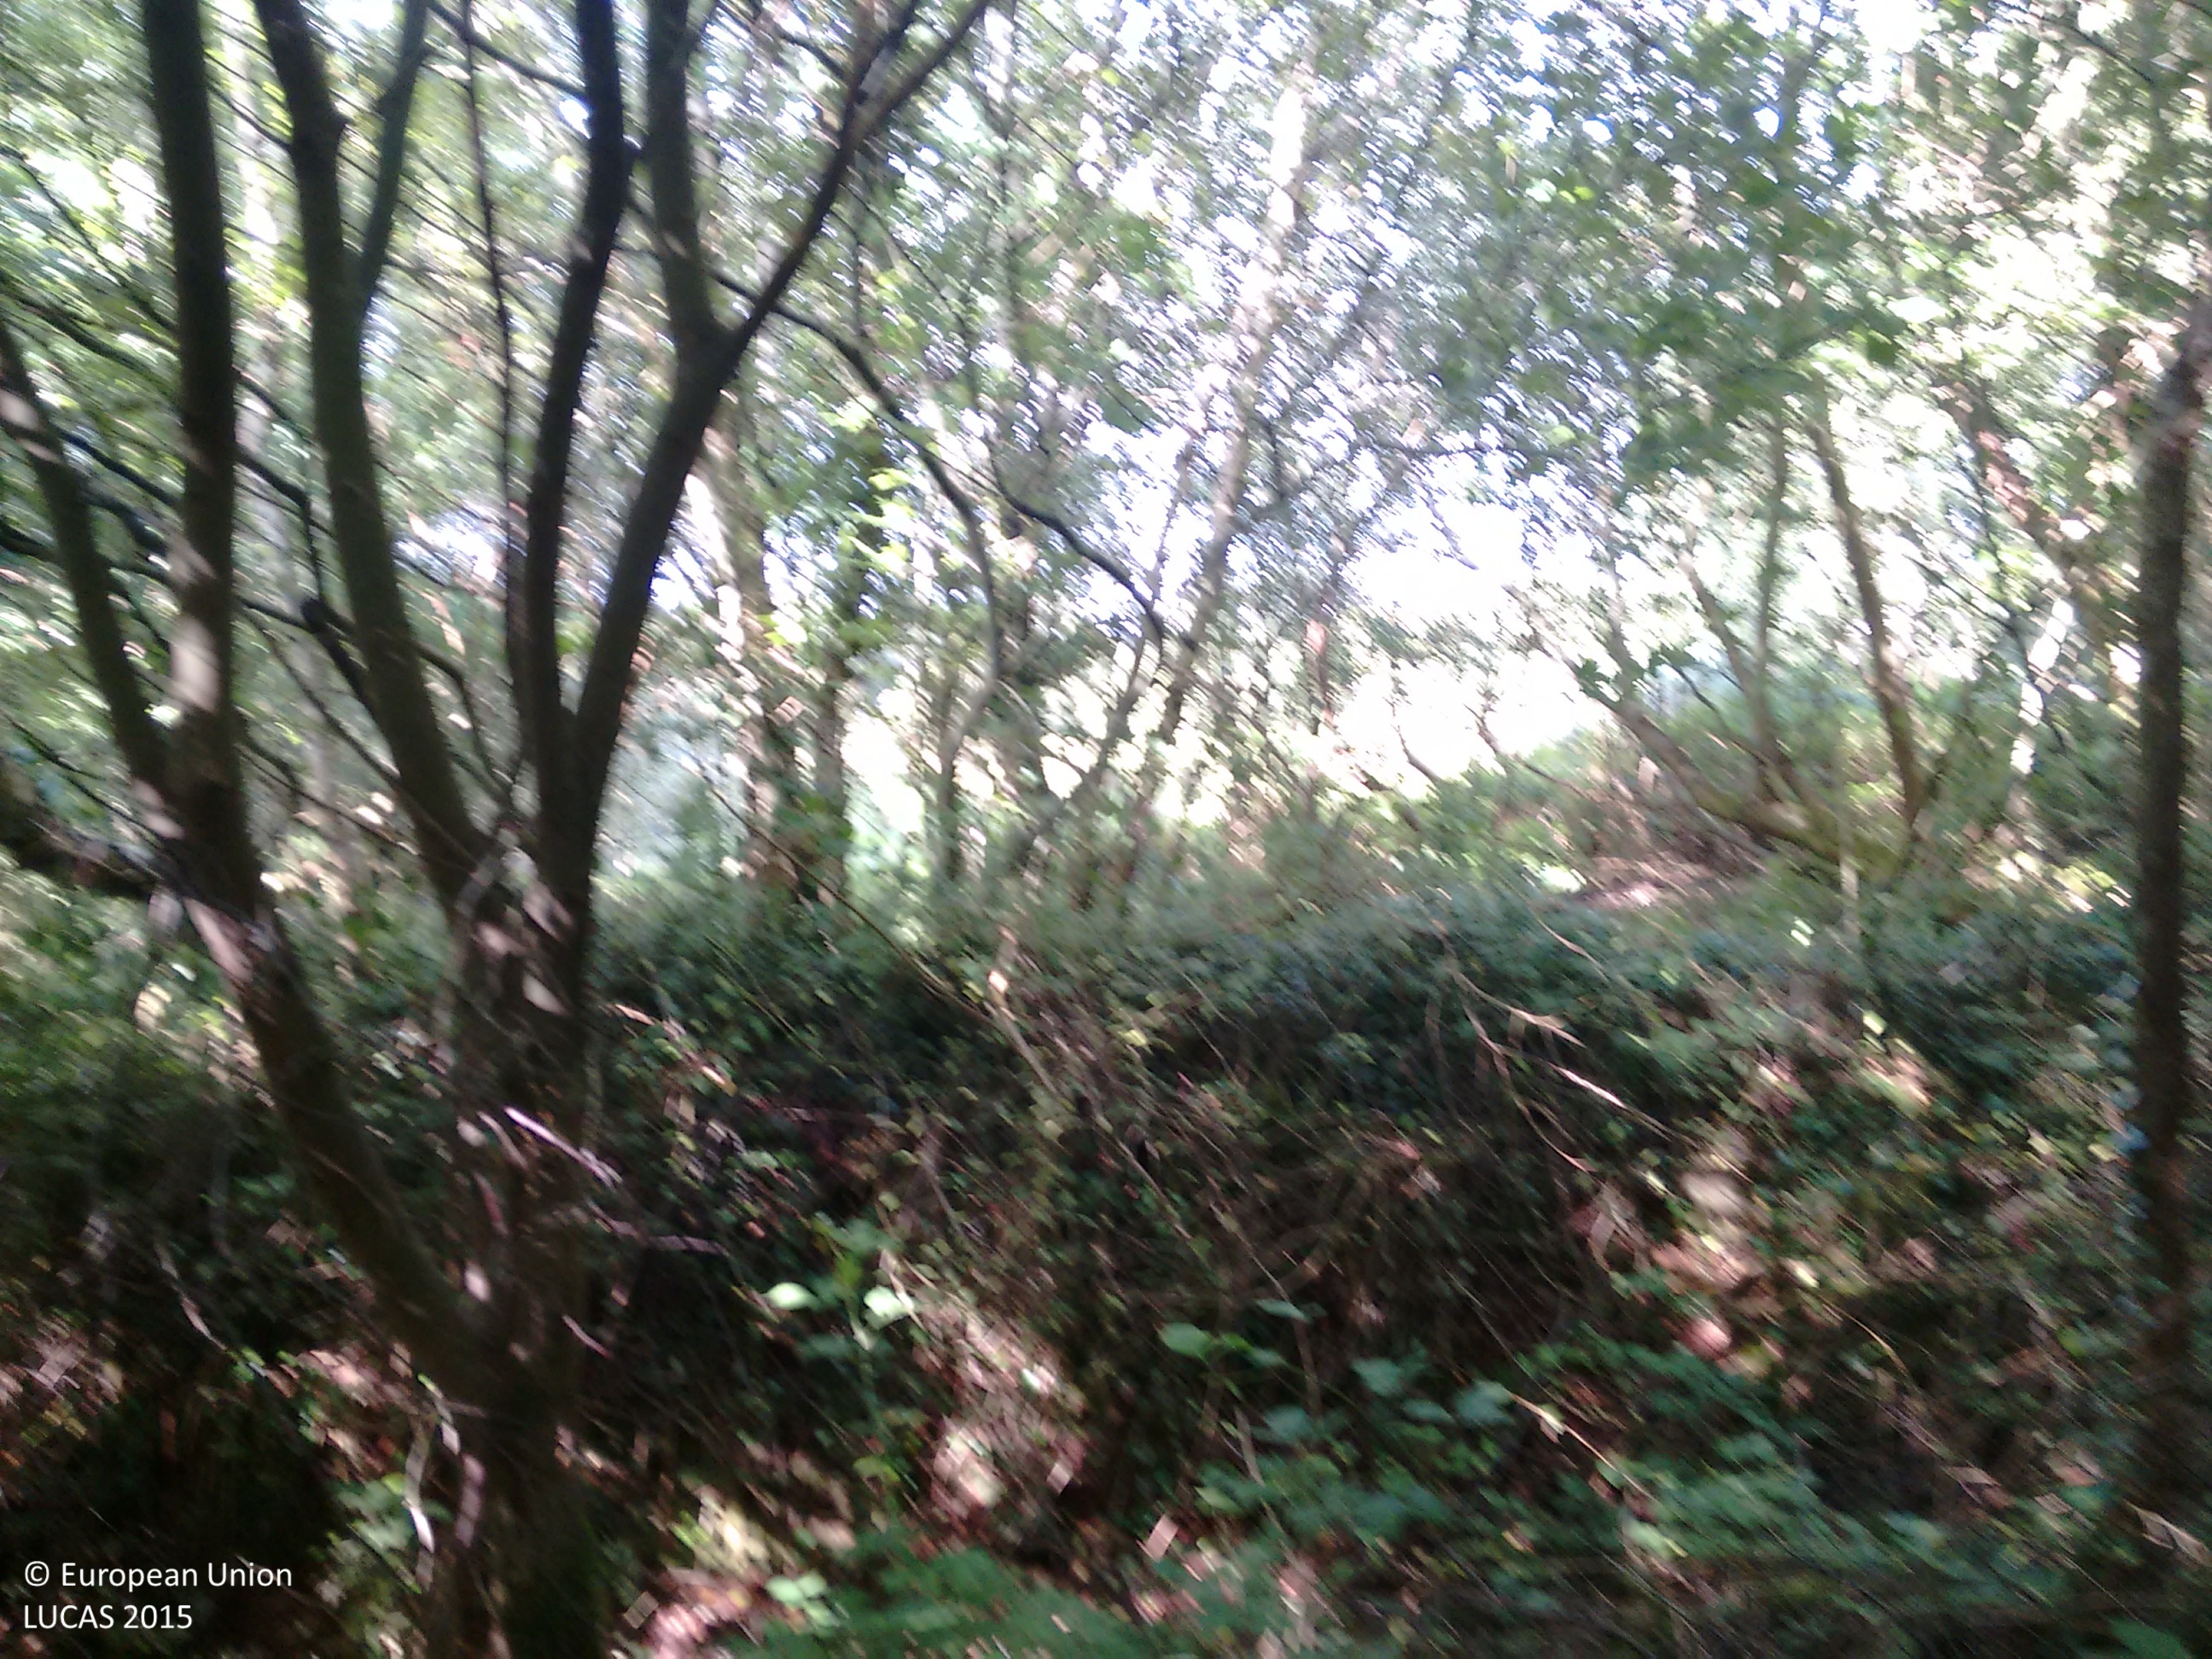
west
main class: Woodland
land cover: Broadleaved woodland
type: acidophilous oak and oak-birch forest
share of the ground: > 75 %
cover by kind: broadleaved forest trees 100 %
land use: Semi-natural and natural areas not in use
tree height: > 5 m
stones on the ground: < 10 %
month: August
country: IE
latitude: 51.8957
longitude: -9.5479
